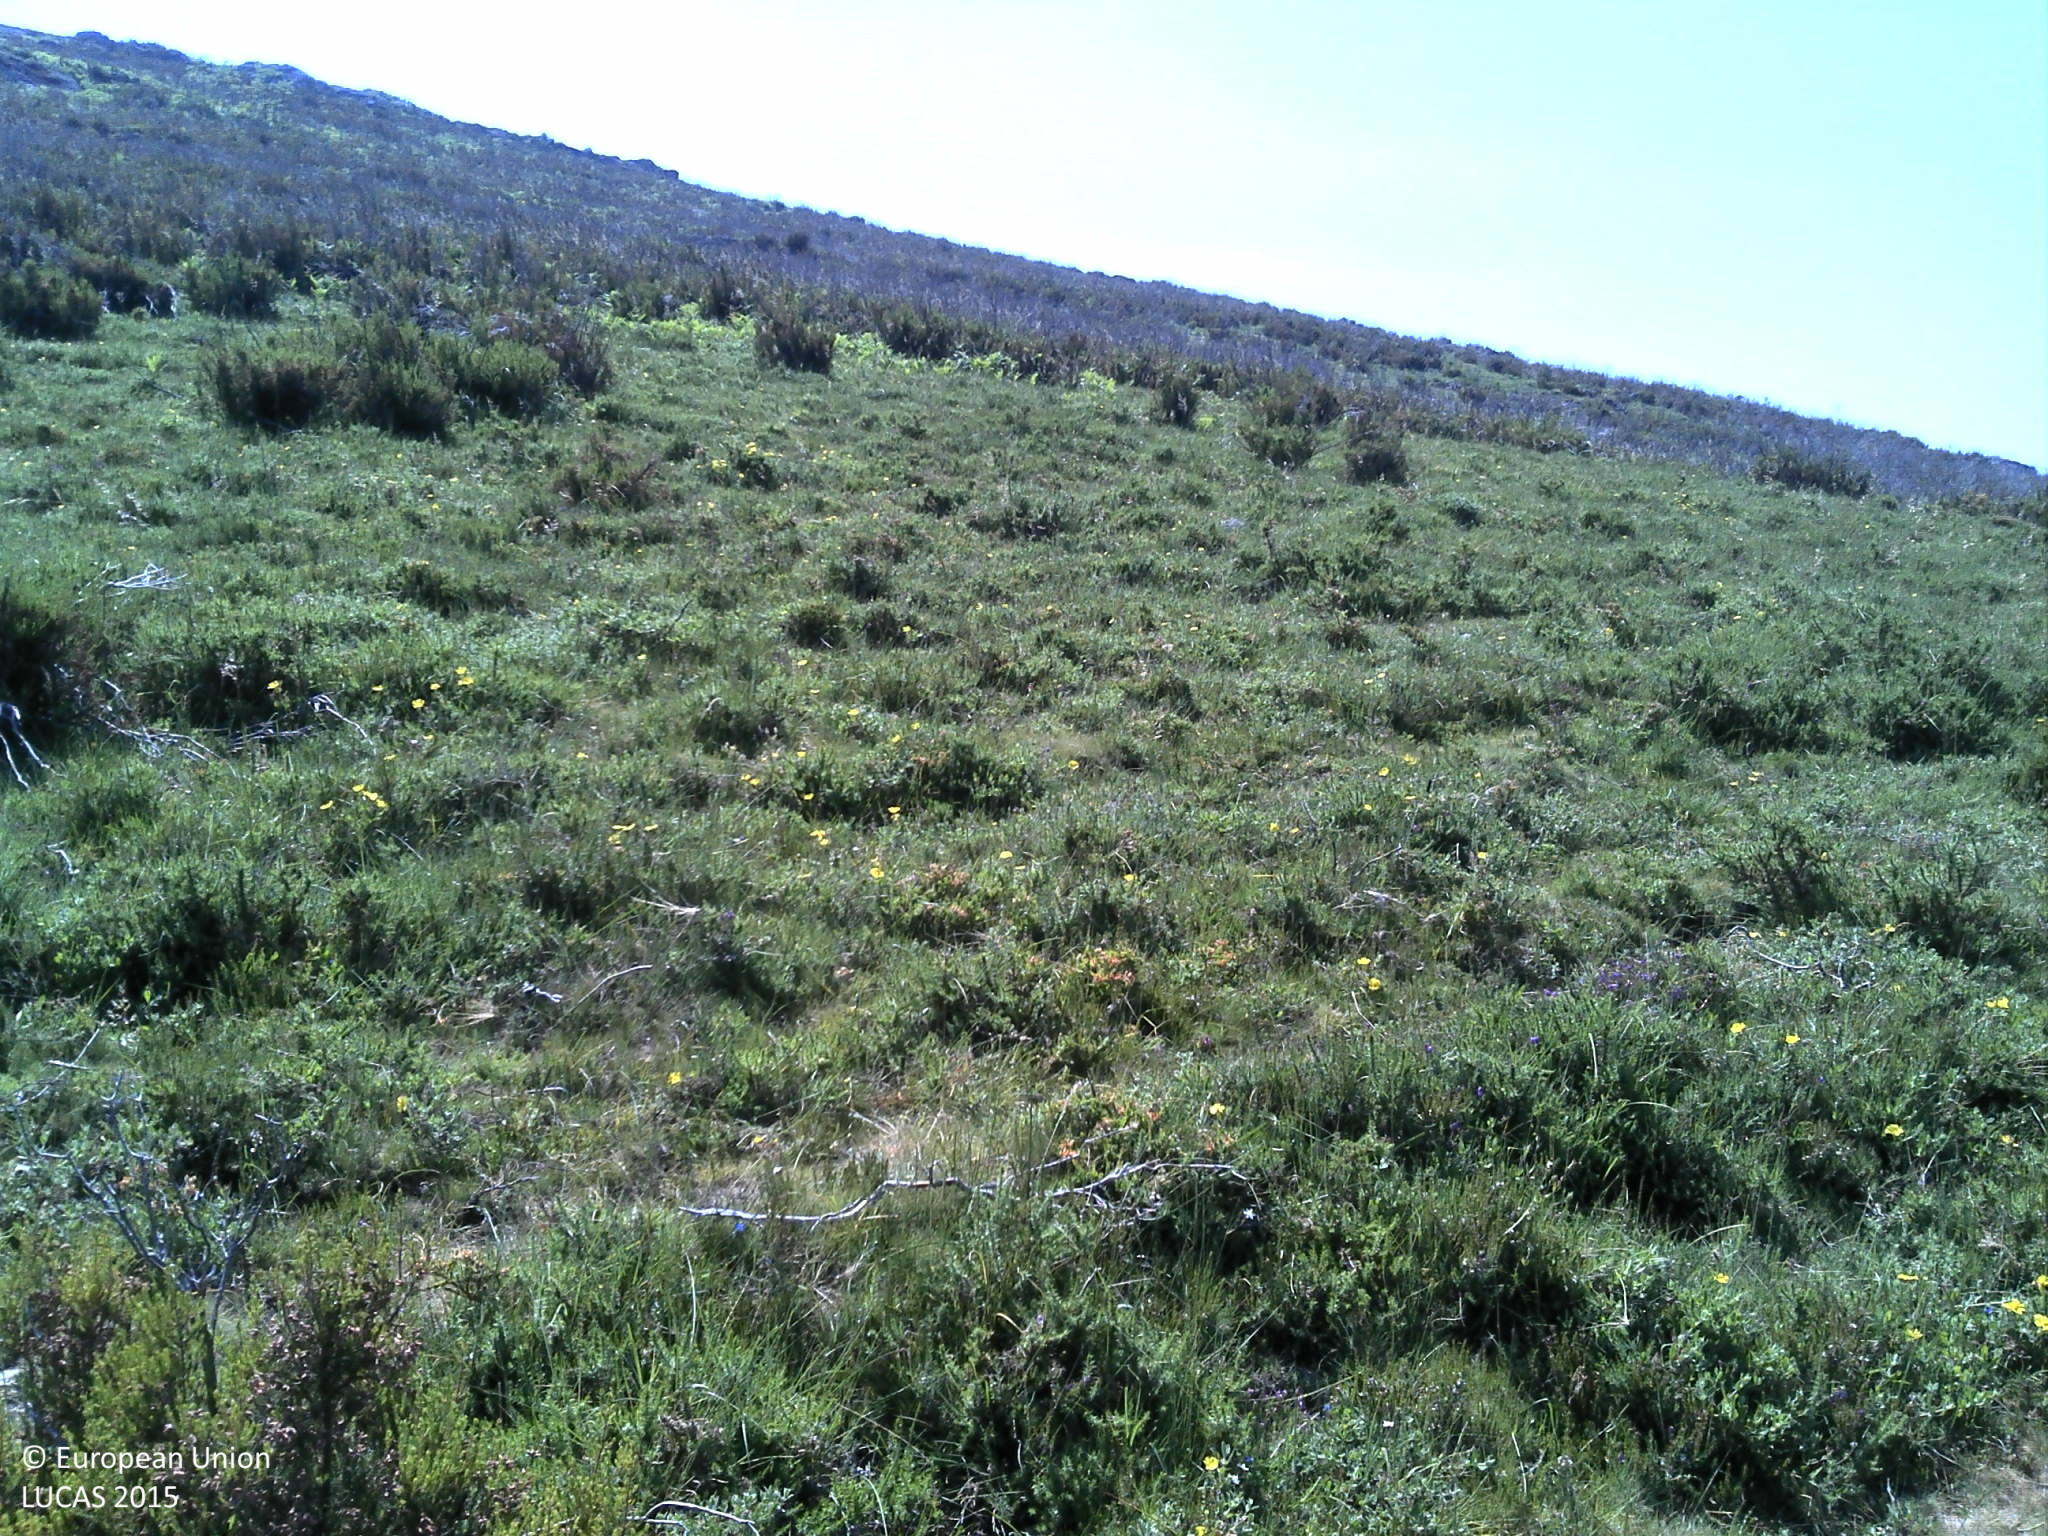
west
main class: Shrubland
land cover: Shrubland without tree cover
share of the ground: 25 - 50 %
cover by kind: shrubs 50 %, herbaceous plants 45 %, unconsolidated bare surface 5 %
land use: Agriculture (excluding fallow land and kitchen gardens)
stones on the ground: 10 - 25 %
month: June
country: PT
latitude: 41.9904
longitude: -8.2750
